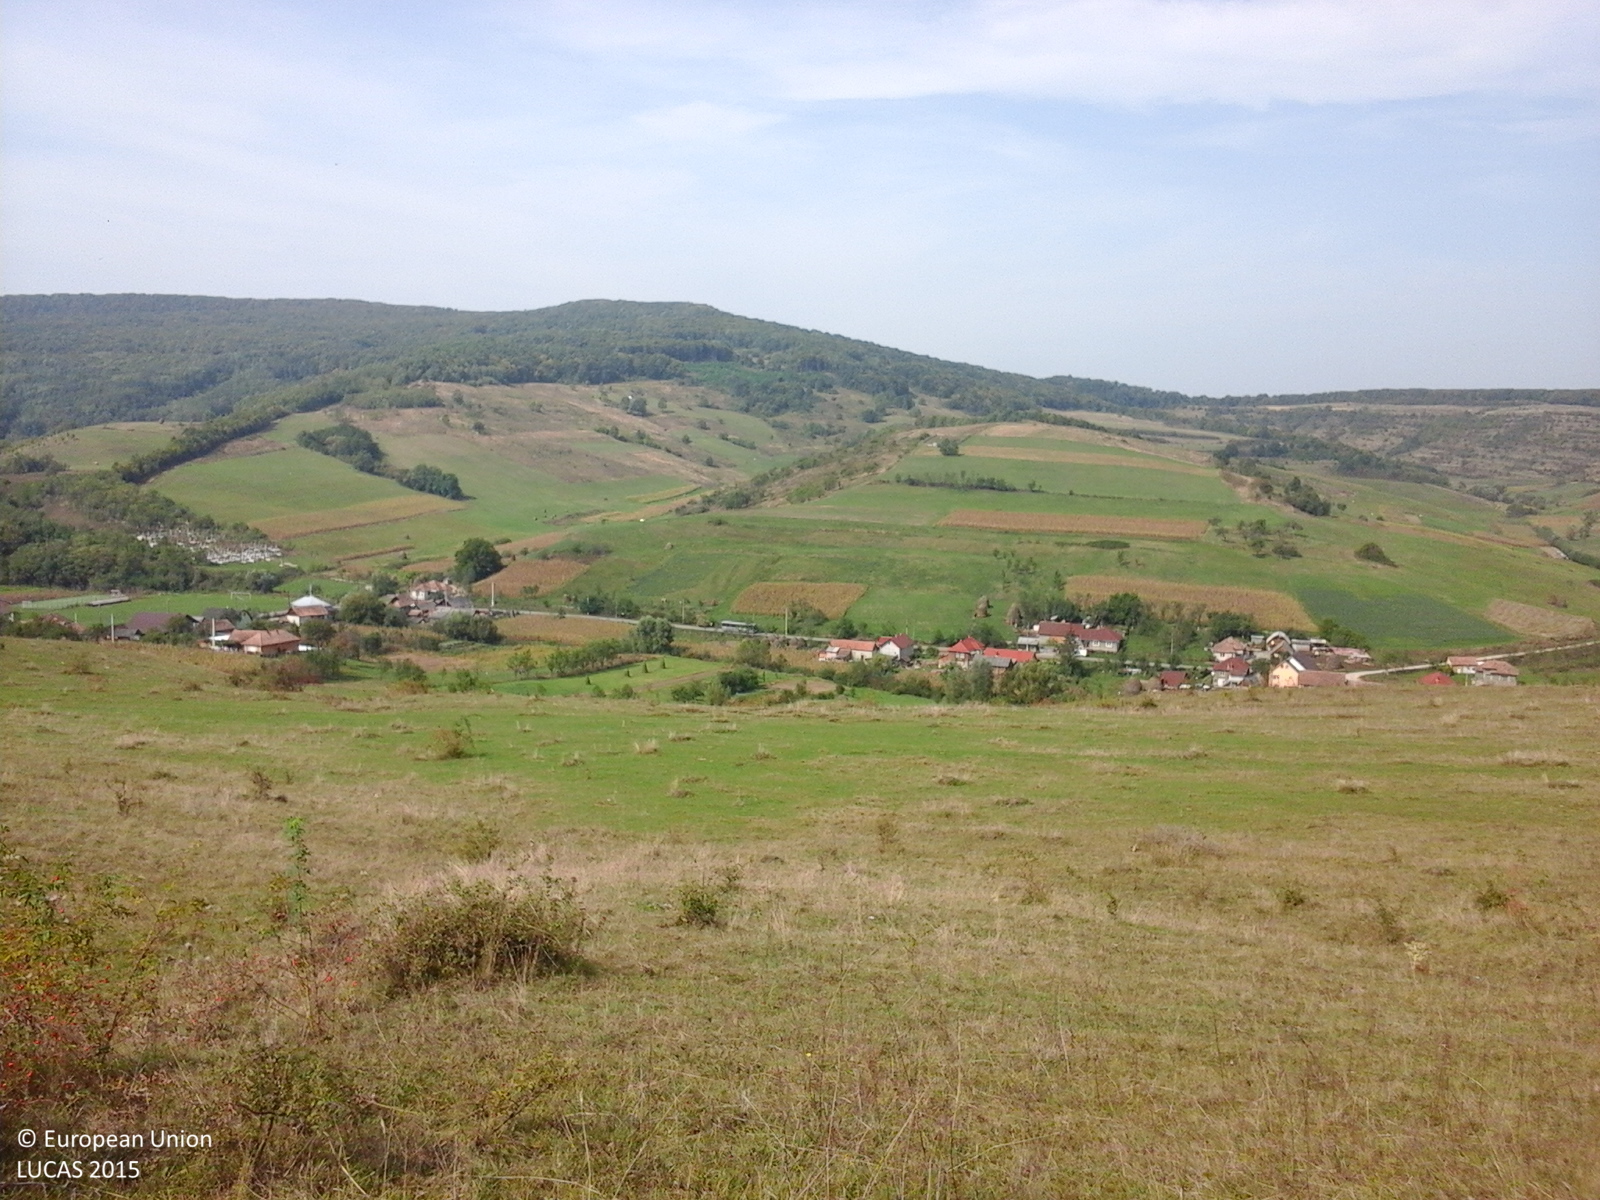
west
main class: Grassland
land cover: Grassland with sparse tree/shrub cover
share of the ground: > 75 %
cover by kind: herbaceous plants 85 %, shrubs 10 %, broadleaved forest trees 5 %
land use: Agriculture (excluding fallow land and kitchen gardens)
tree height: < 5 m
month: September
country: RO
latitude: 47.1312
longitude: 23.8011
